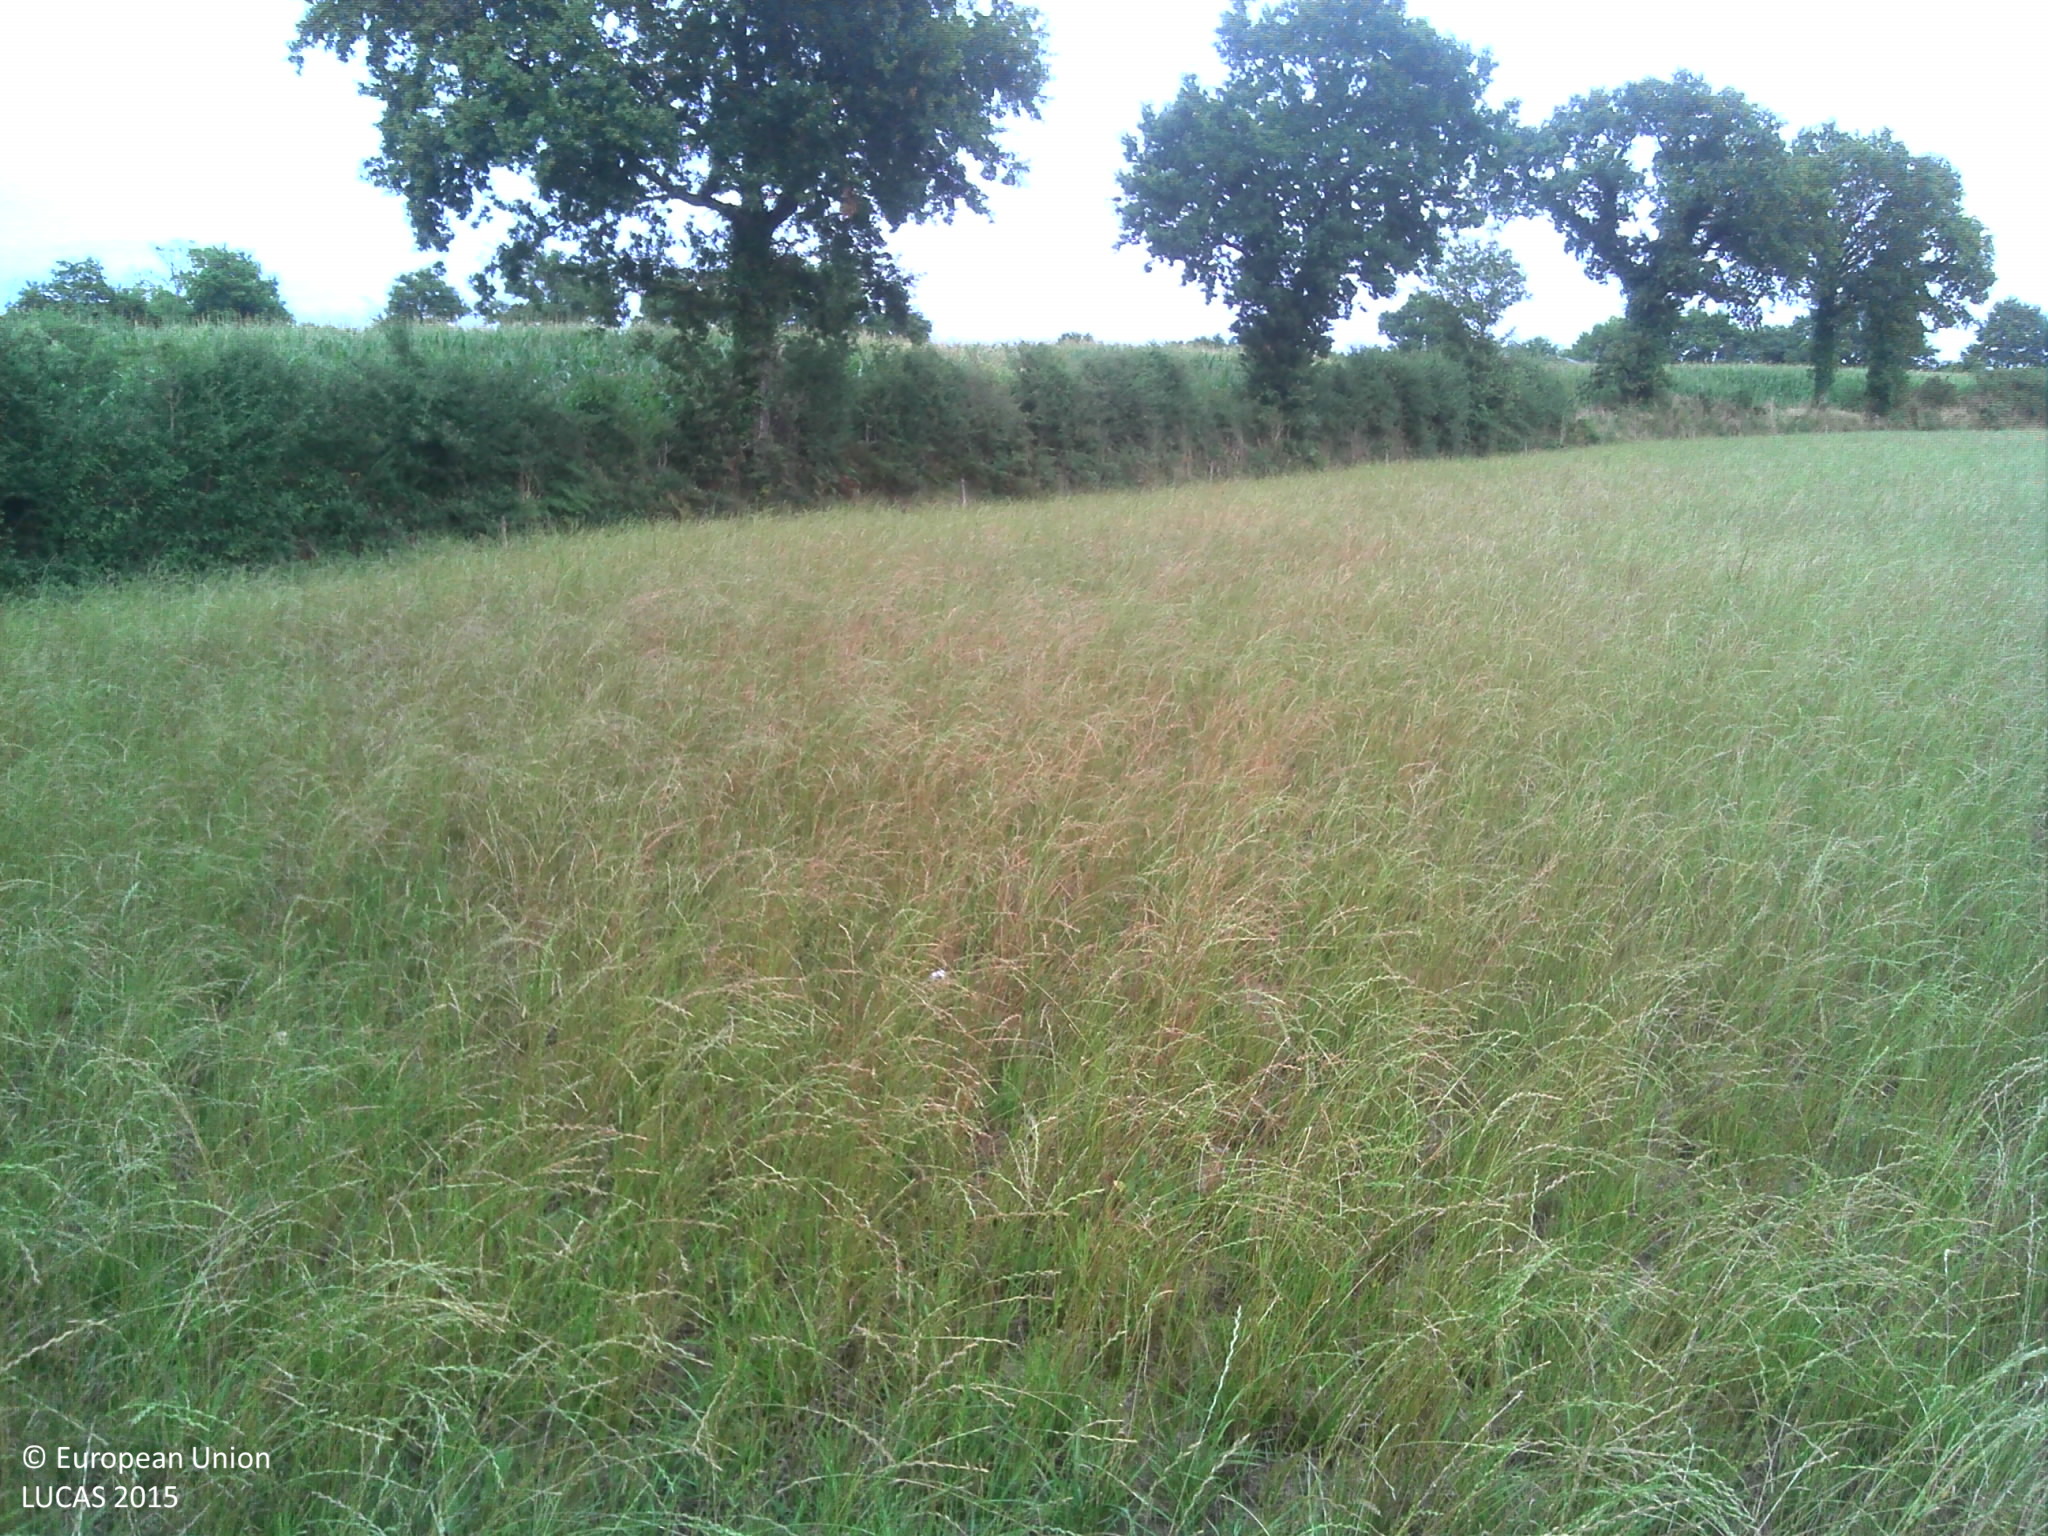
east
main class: Grassland
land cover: Grassland without tree/shrub cover
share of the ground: > 75 %
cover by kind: herbaceous plants 100 %
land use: Agriculture (excluding fallow land and kitchen gardens)
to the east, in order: Grassland without tree/shrub cover; Fences; Abandoned hedges; Fences; Maize; Artificial constructions in urban areas
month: August
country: FR
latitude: 46.6422
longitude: -1.6282
